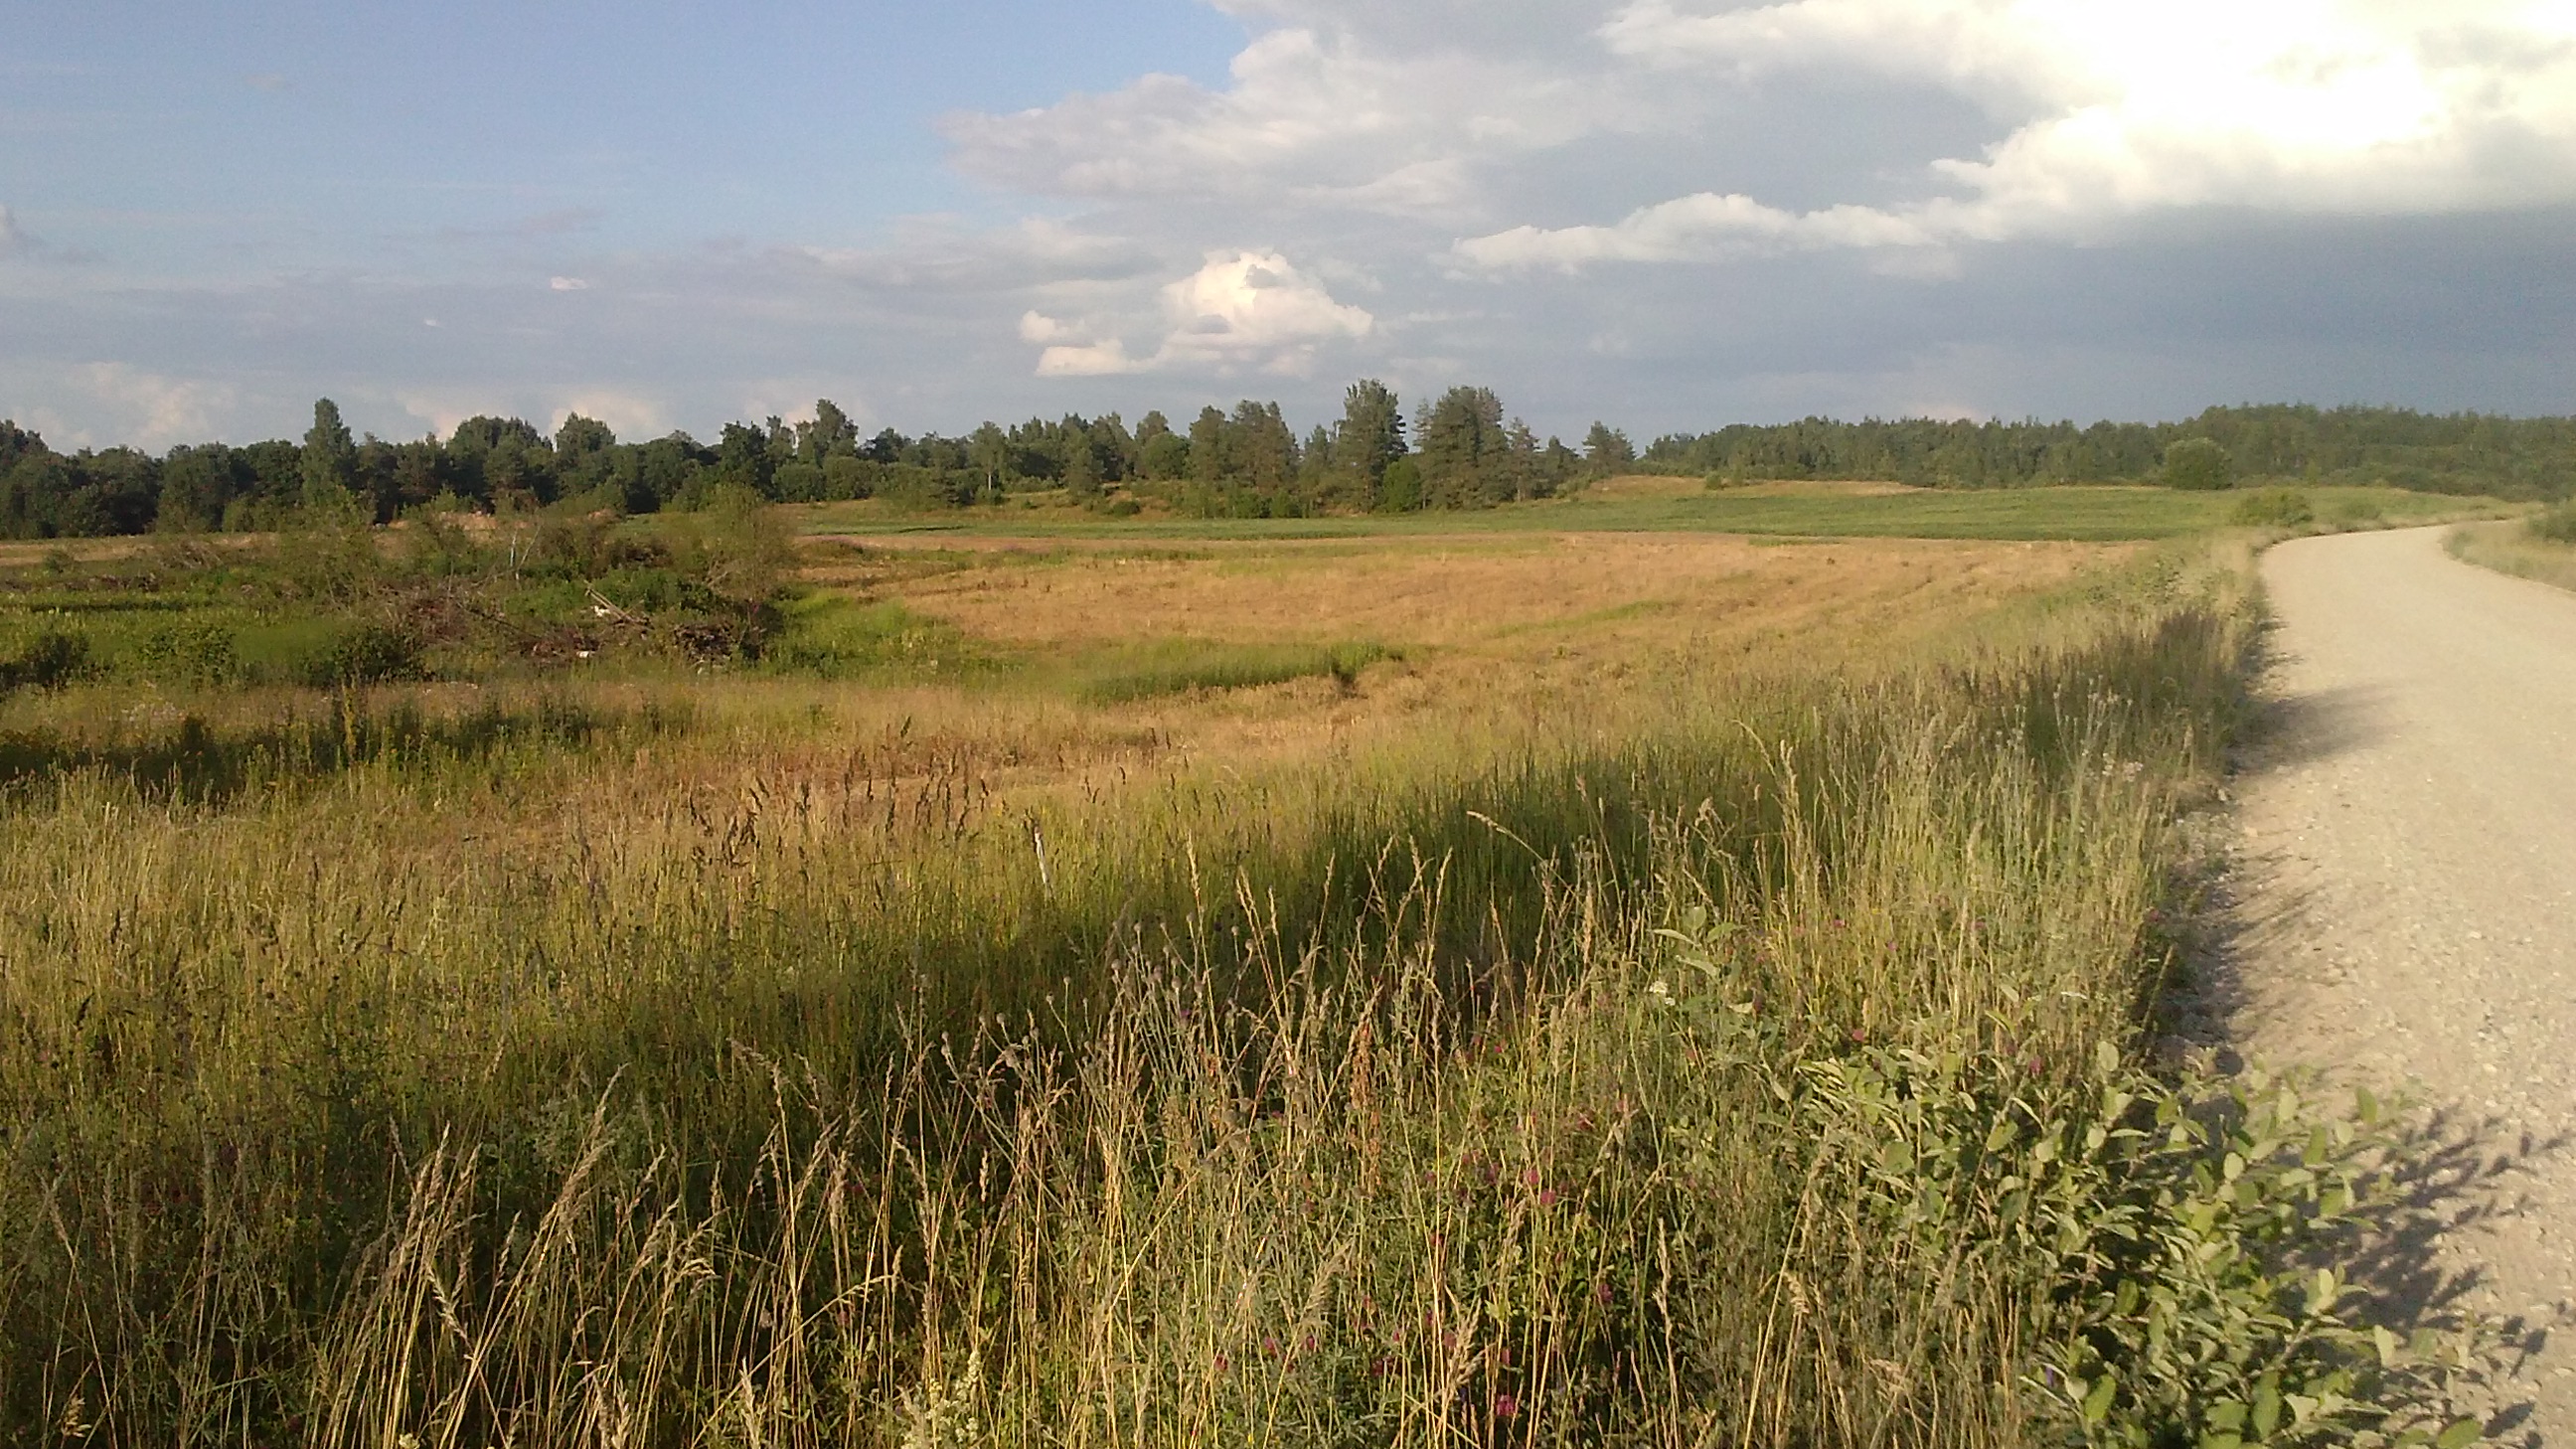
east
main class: Grassland
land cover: Grassland without tree/shrub cover
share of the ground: > 75 %
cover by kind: herbaceous plants 100 %
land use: Agriculture (excluding fallow land and kitchen gardens)
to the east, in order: Grassland without tree/shrub cover; Broadleaved woodland; Grassland without tree/shrub cover
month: June
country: LV
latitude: 56.6351
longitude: 27.6106
